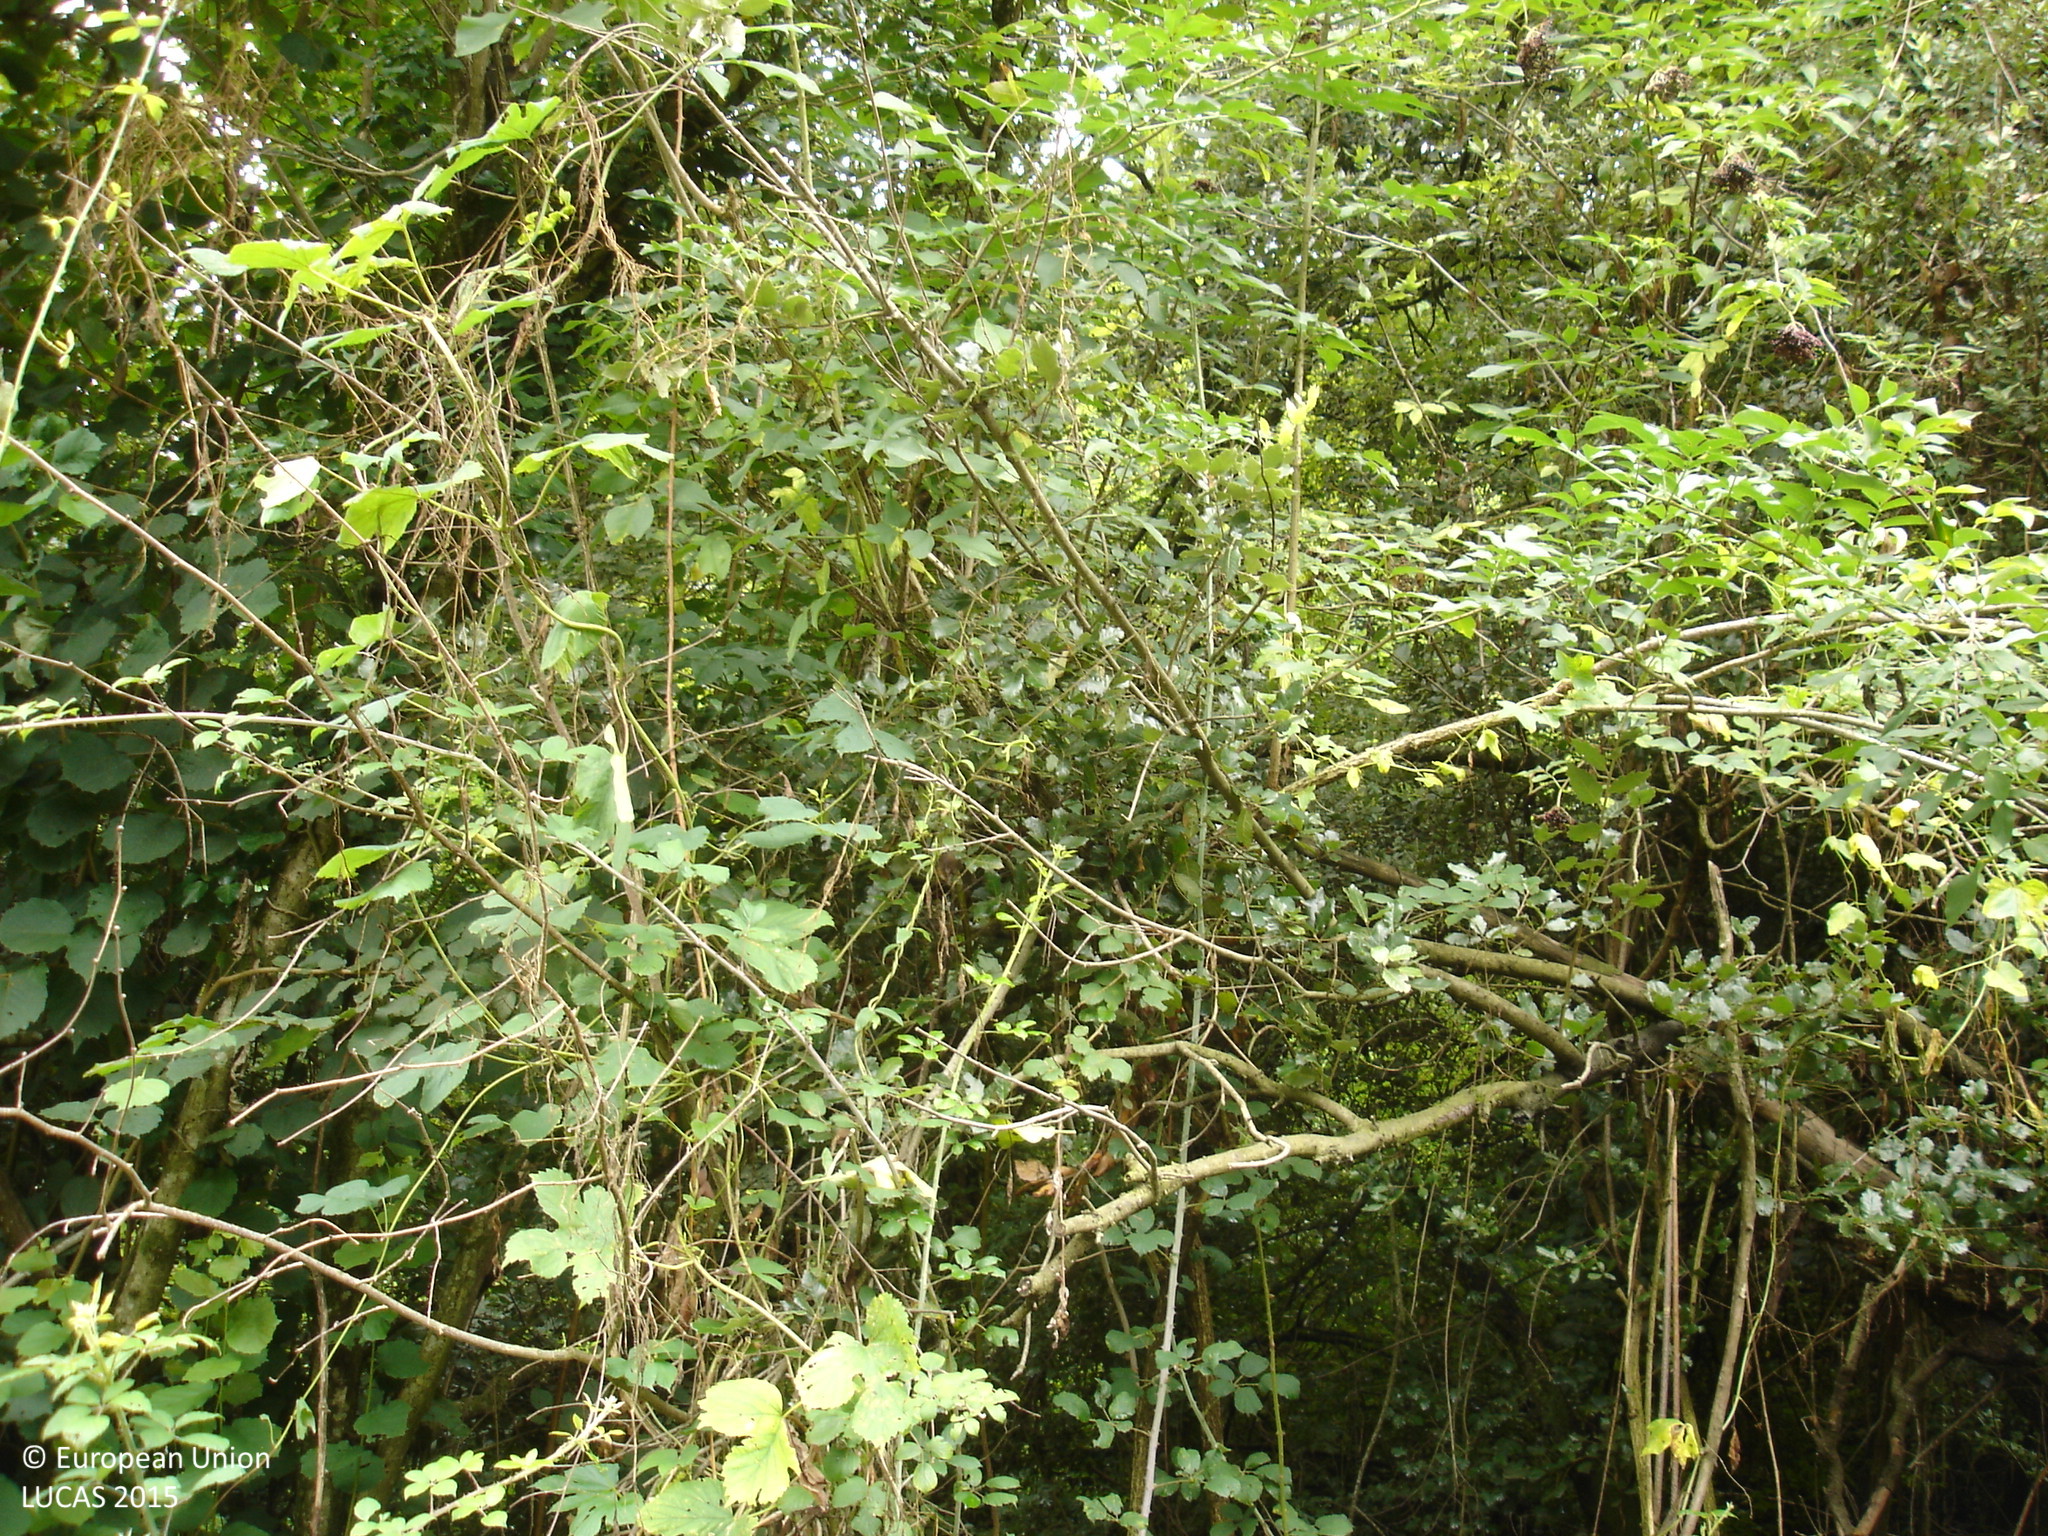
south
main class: Woodland
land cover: Broadleaved woodland
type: thermophilous deciduous forest
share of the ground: > 75 %
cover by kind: broadleaved forest trees 80 %, shrubs 20 %
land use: Forestry
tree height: > 5 m
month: July
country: ES
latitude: 42.1616
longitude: 2.5463
